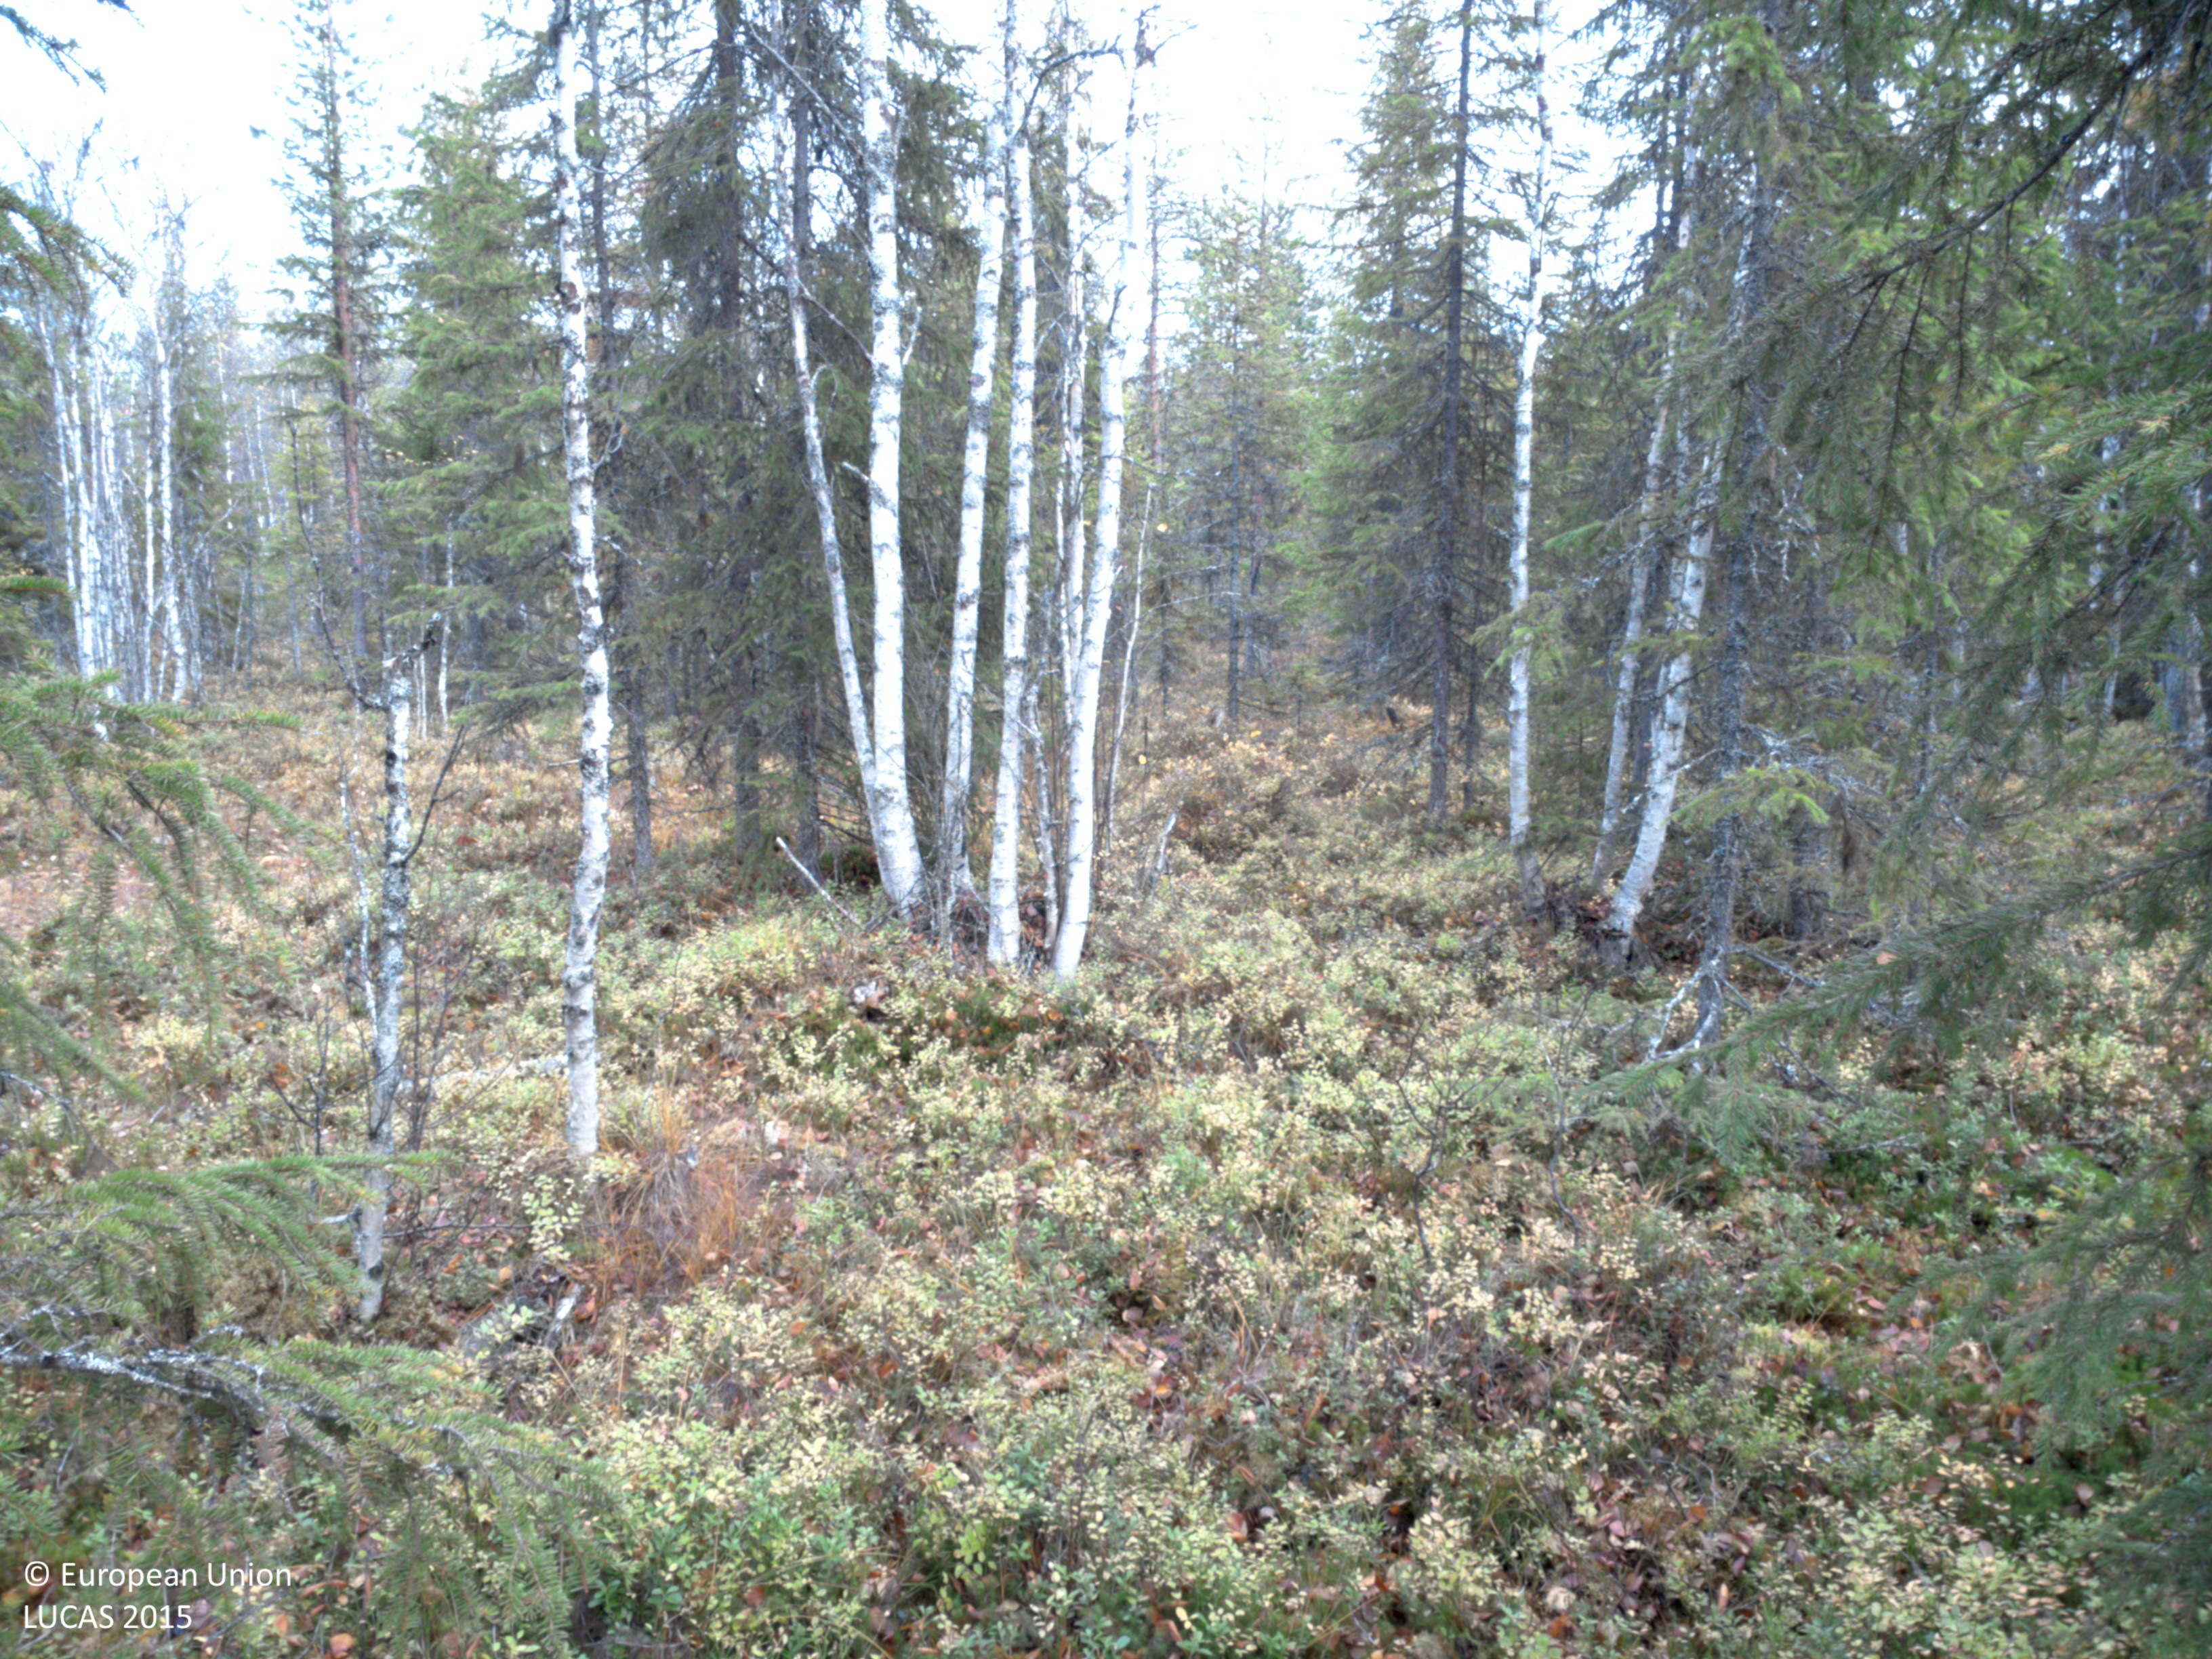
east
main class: Woodland
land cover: Spruce dominated mixed woodland
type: boreal forest
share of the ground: 50 - 75 %
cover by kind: coniferous forest trees 30 %, broadleaved forest trees 30 %, shrubs 30 %, lichens and mosses 10 %
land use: Forestry
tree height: > 5 m
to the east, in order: Spruce dominated mixed woodland; Pine dominated mixed woodland; Pine dominated coniferous woodland; Pine dominated mixed woodland; Other coniferous woodland
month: October
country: SE
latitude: 64.7924
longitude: 18.0671
